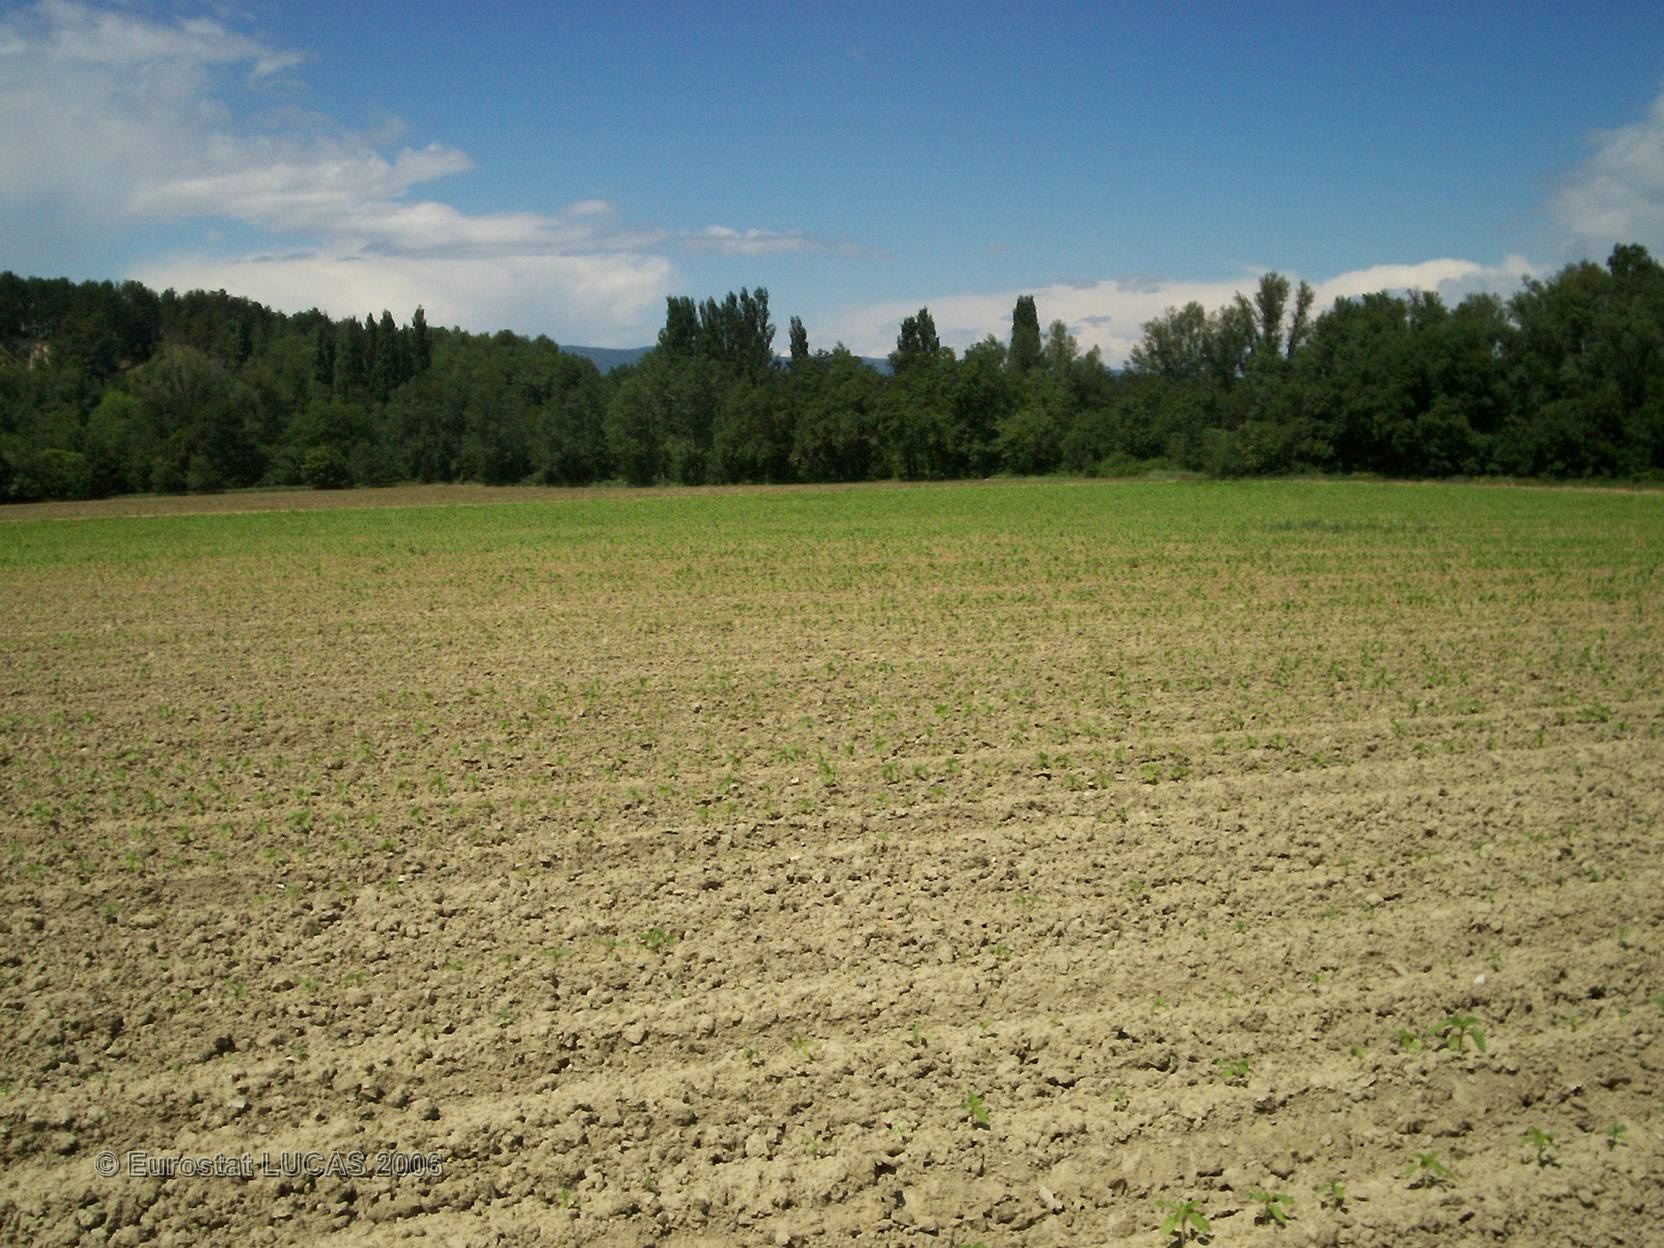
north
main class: Cropland
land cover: Sunflower
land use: Agriculture (excluding fallow land and kitchen gardens)
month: May
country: FR
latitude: 44.5483
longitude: 4.8585
